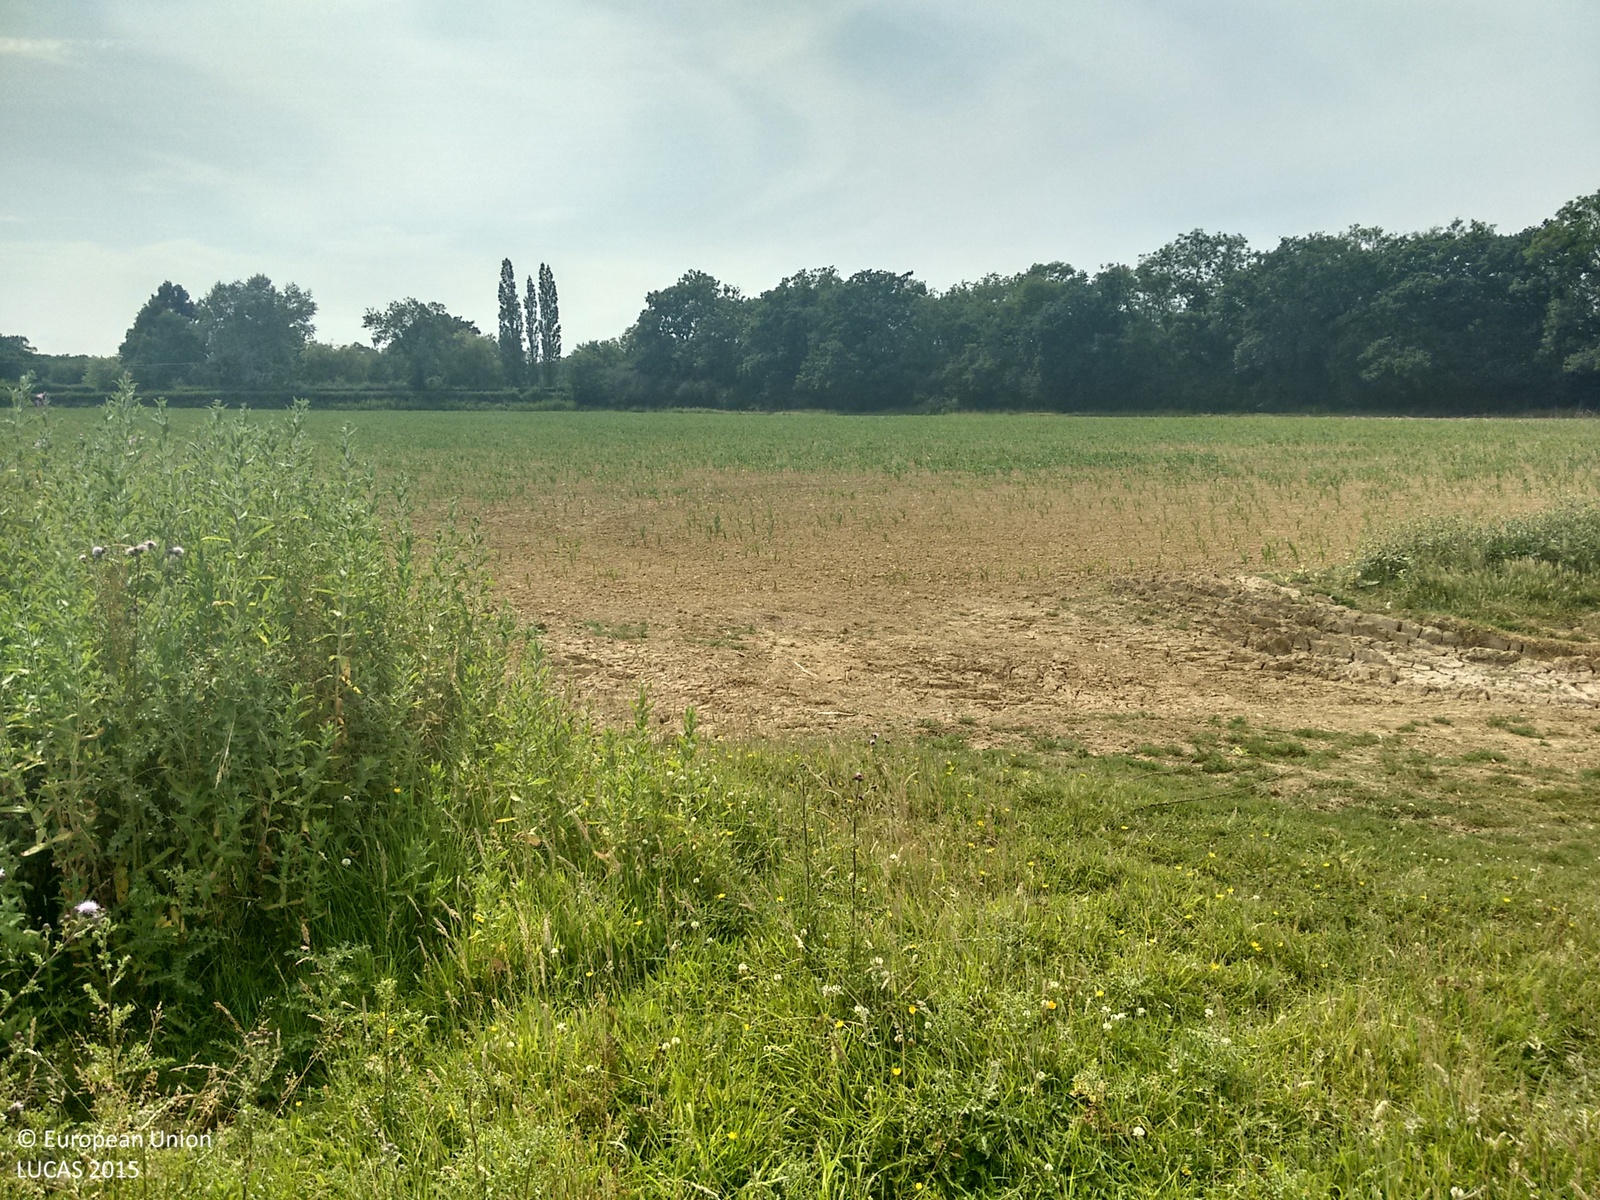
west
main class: Shrubland
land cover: Shrubland with sparse tree cover
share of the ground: > 75 %
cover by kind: shrubs 75 %, herbaceous plants 20 %, broadleaved forest trees 5 %
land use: Semi-natural and natural areas not in use
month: July
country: GB
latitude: 51.1930
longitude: -0.2090
